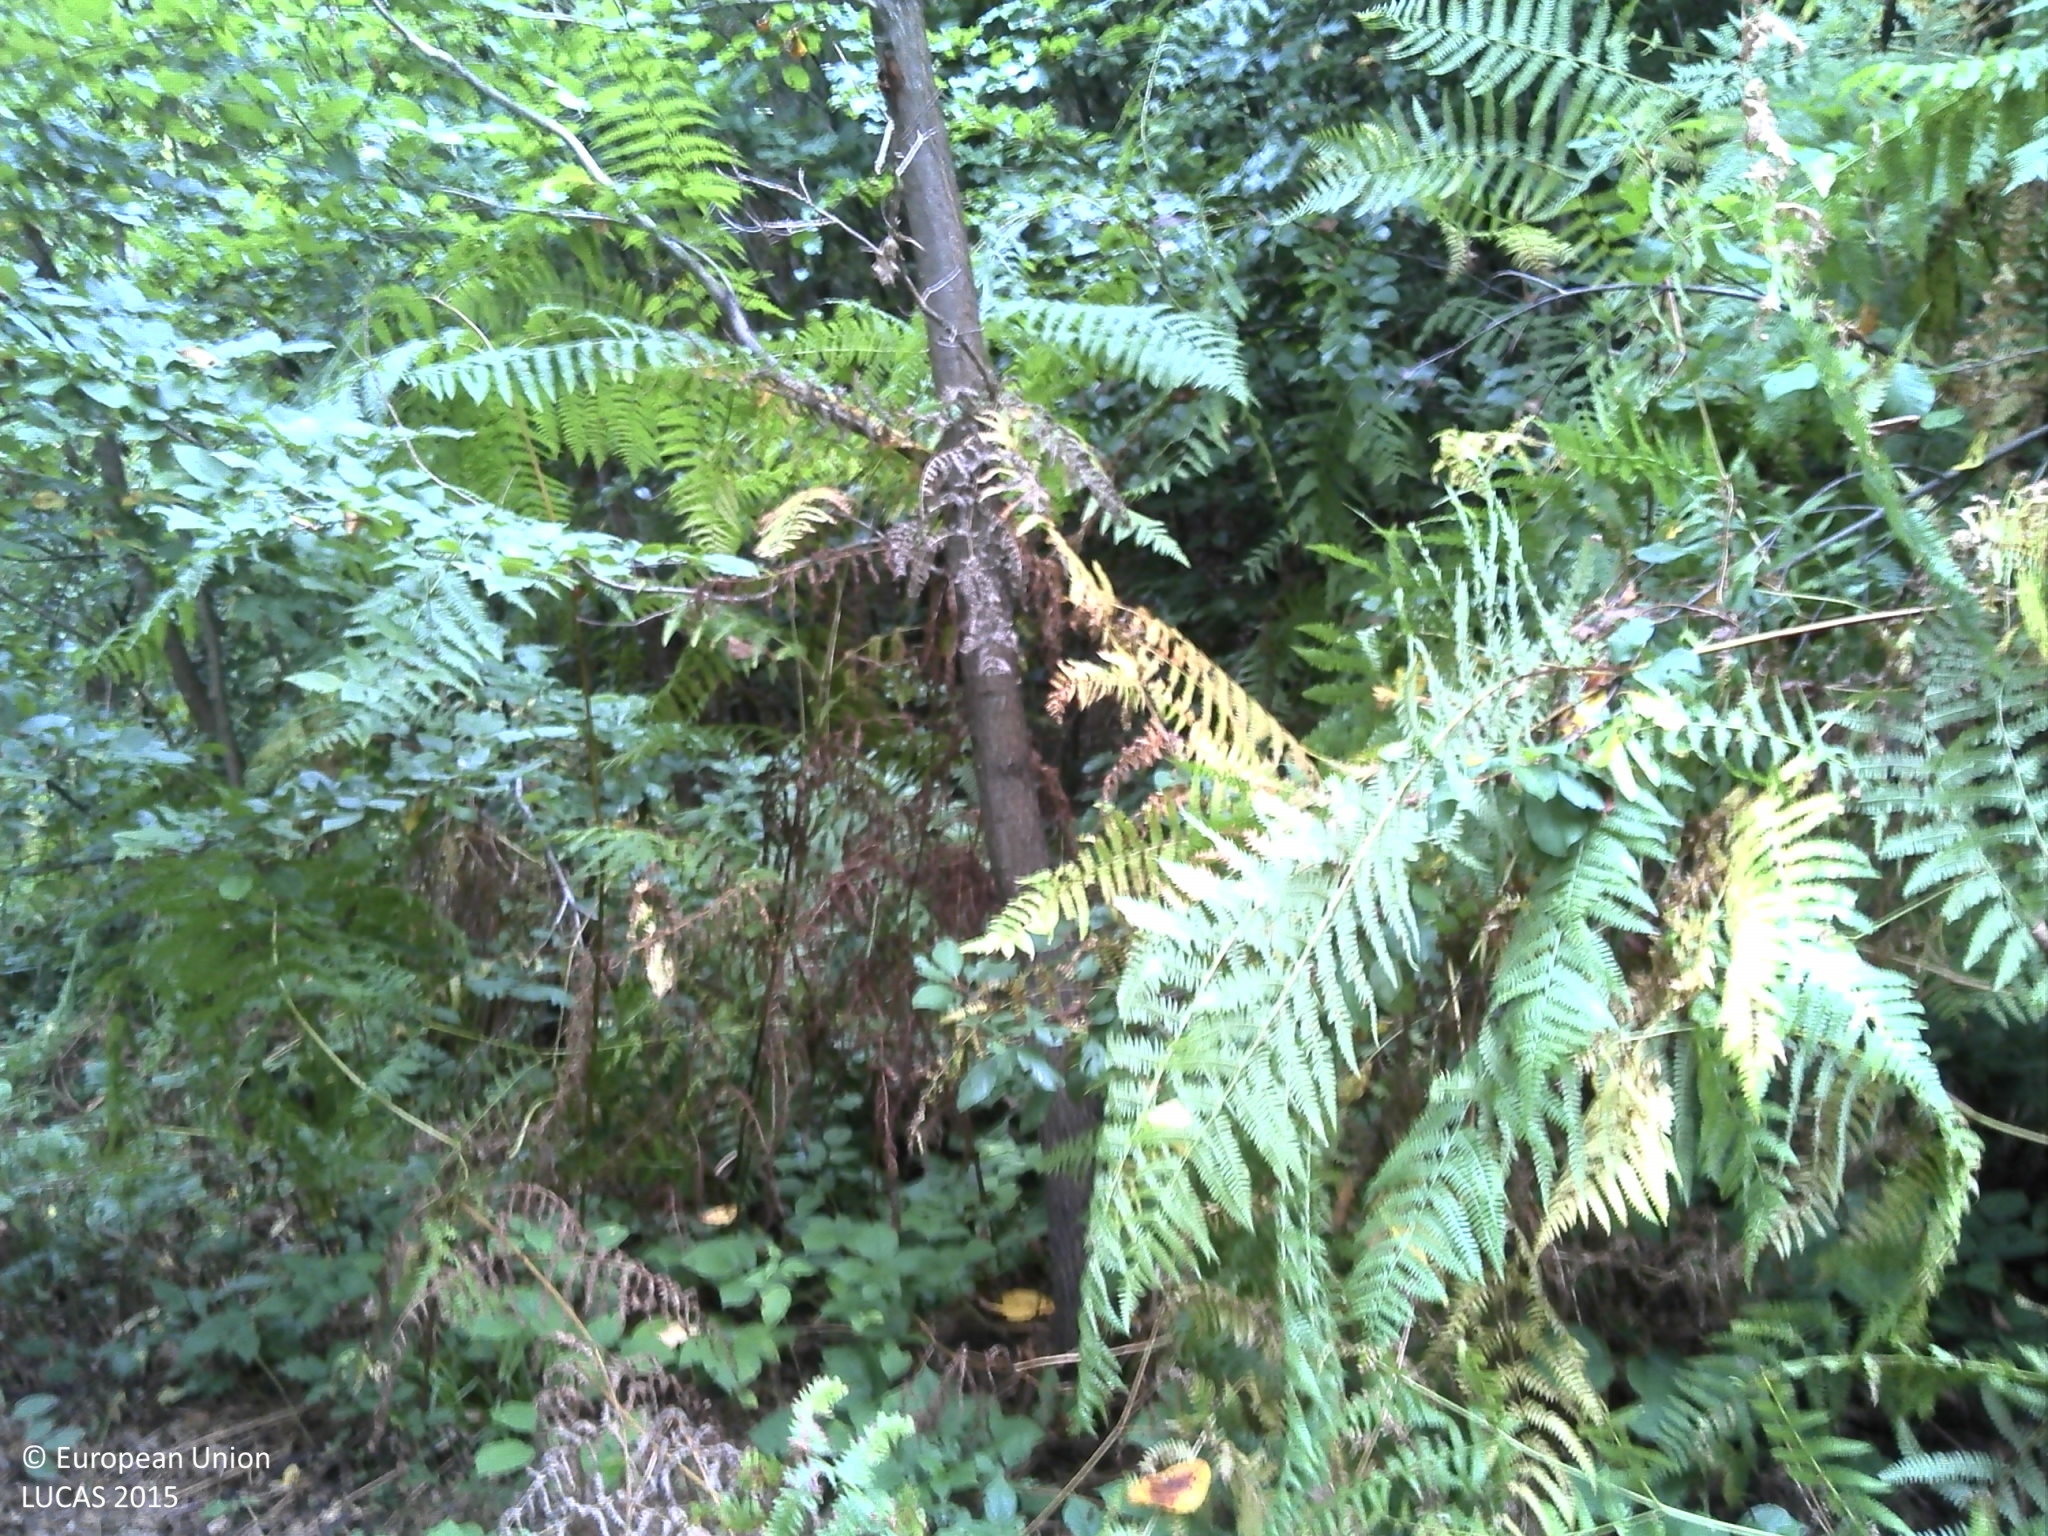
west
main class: Woodland
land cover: Broadleaved woodland
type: beech forest
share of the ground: > 75 %
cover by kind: broadleaved forest trees 100 %
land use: Forestry
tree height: > 5 m
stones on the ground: < 10 %
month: August
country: HR
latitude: 45.2450
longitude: 15.9714
